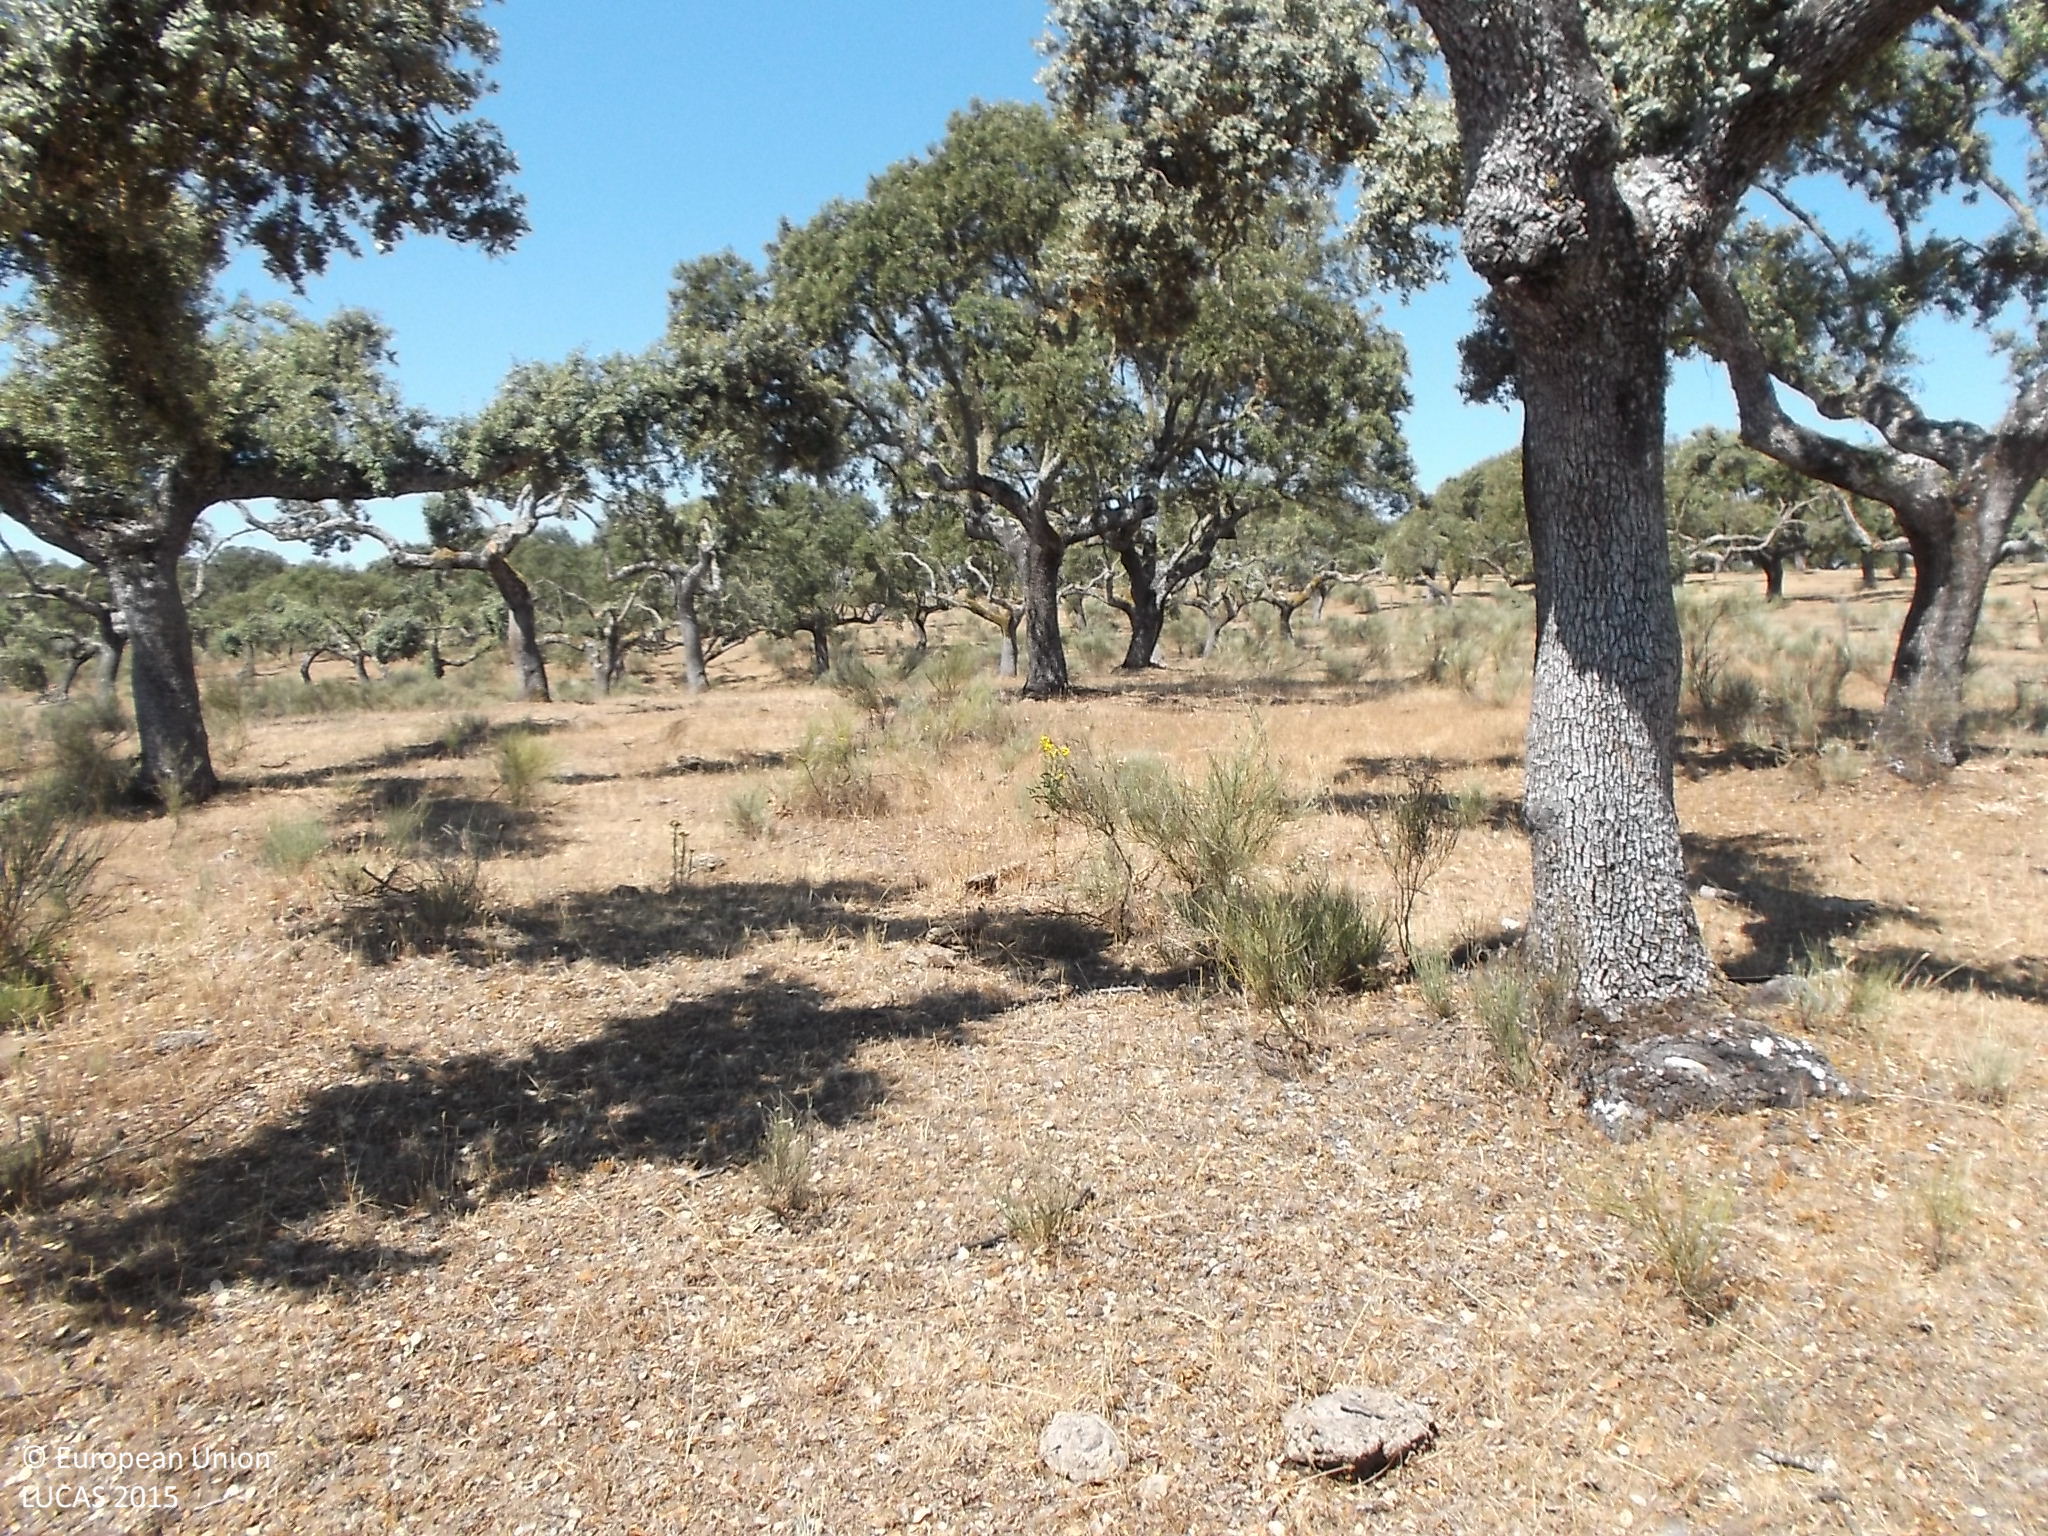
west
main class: Woodland
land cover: Broadleaved woodland
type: broadleaved evergreen forest
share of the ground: 50 - 75 %
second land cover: Shrubland without tree cover
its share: 10 - 25 %
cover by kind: broadleaved forest trees 60 %, shrubs 20 %, herbaceous plants 20 %
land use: Forestry
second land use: Agriculture (excluding fallow land and kitchen gardens)
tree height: < 5 m
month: July
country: ES
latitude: 40.6469
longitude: -6.7095
